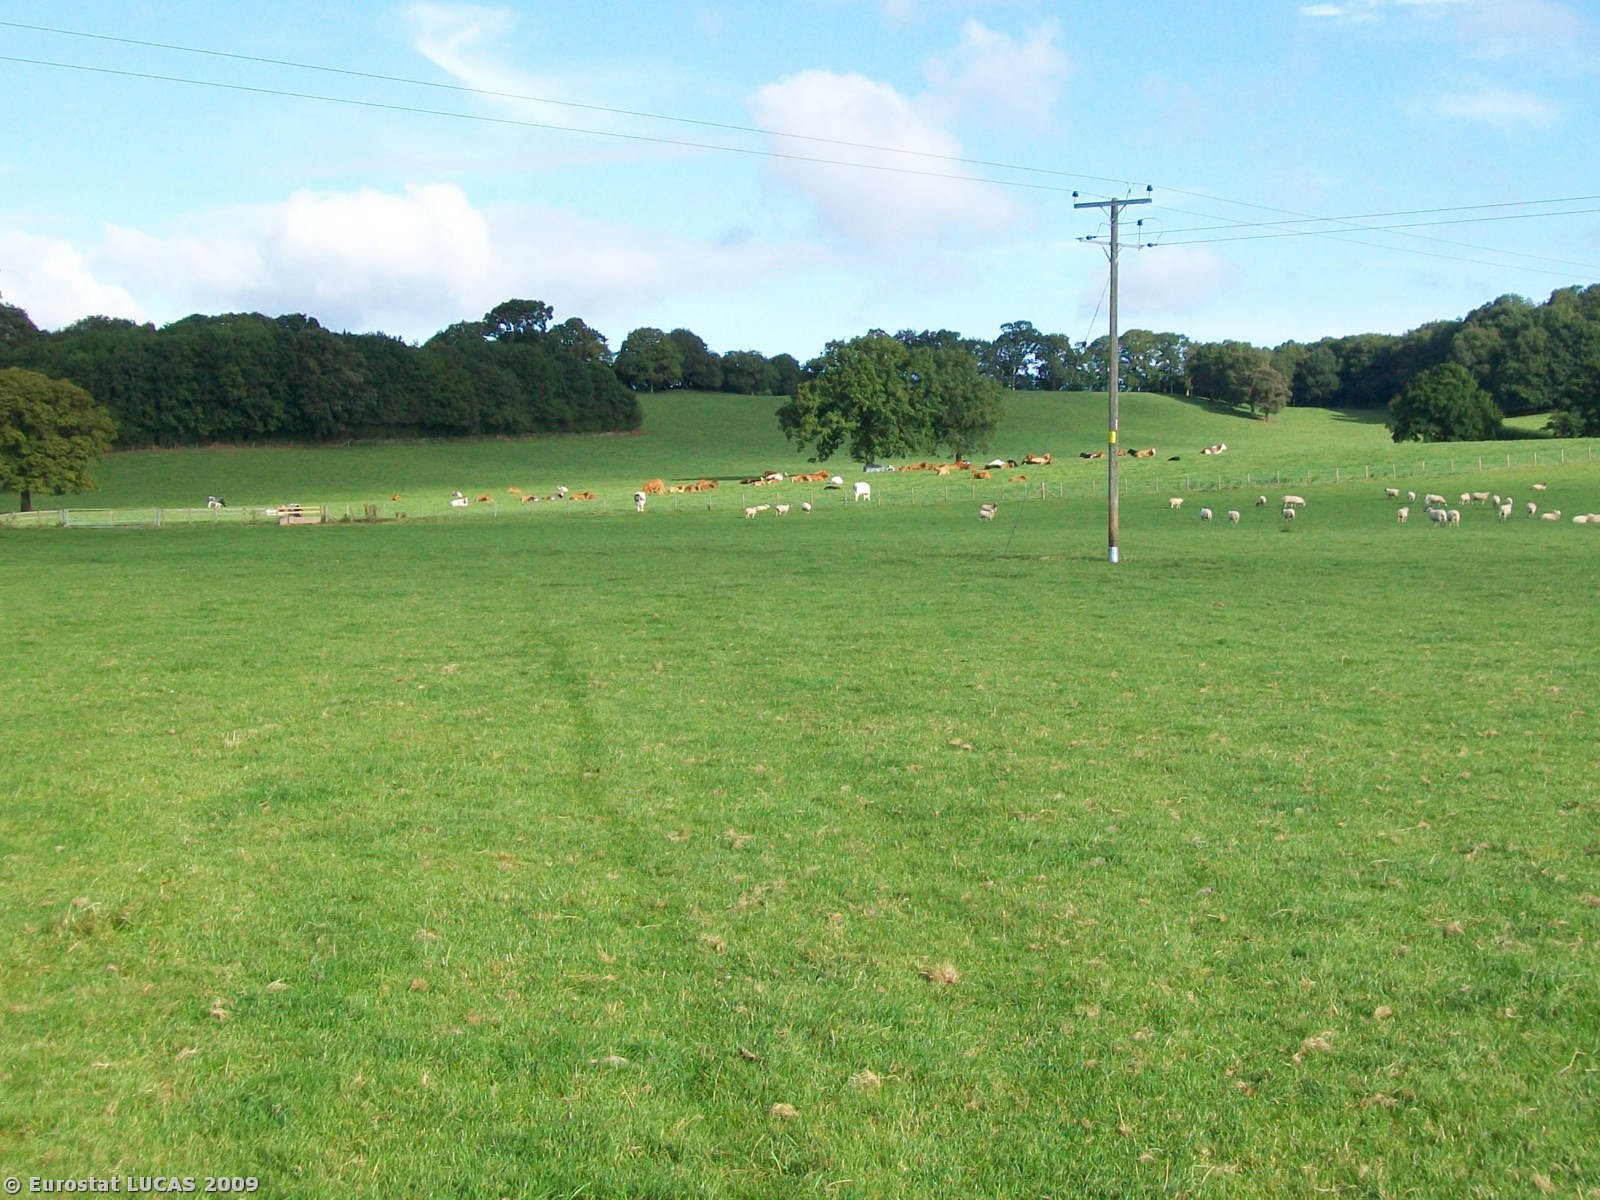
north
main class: Grassland
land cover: Grassland without tree/shrub cover
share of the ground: > 75 %
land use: Agriculture (excluding fallow land and kitchen gardens)
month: September
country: GB
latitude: 52.0793
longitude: -2.4837
